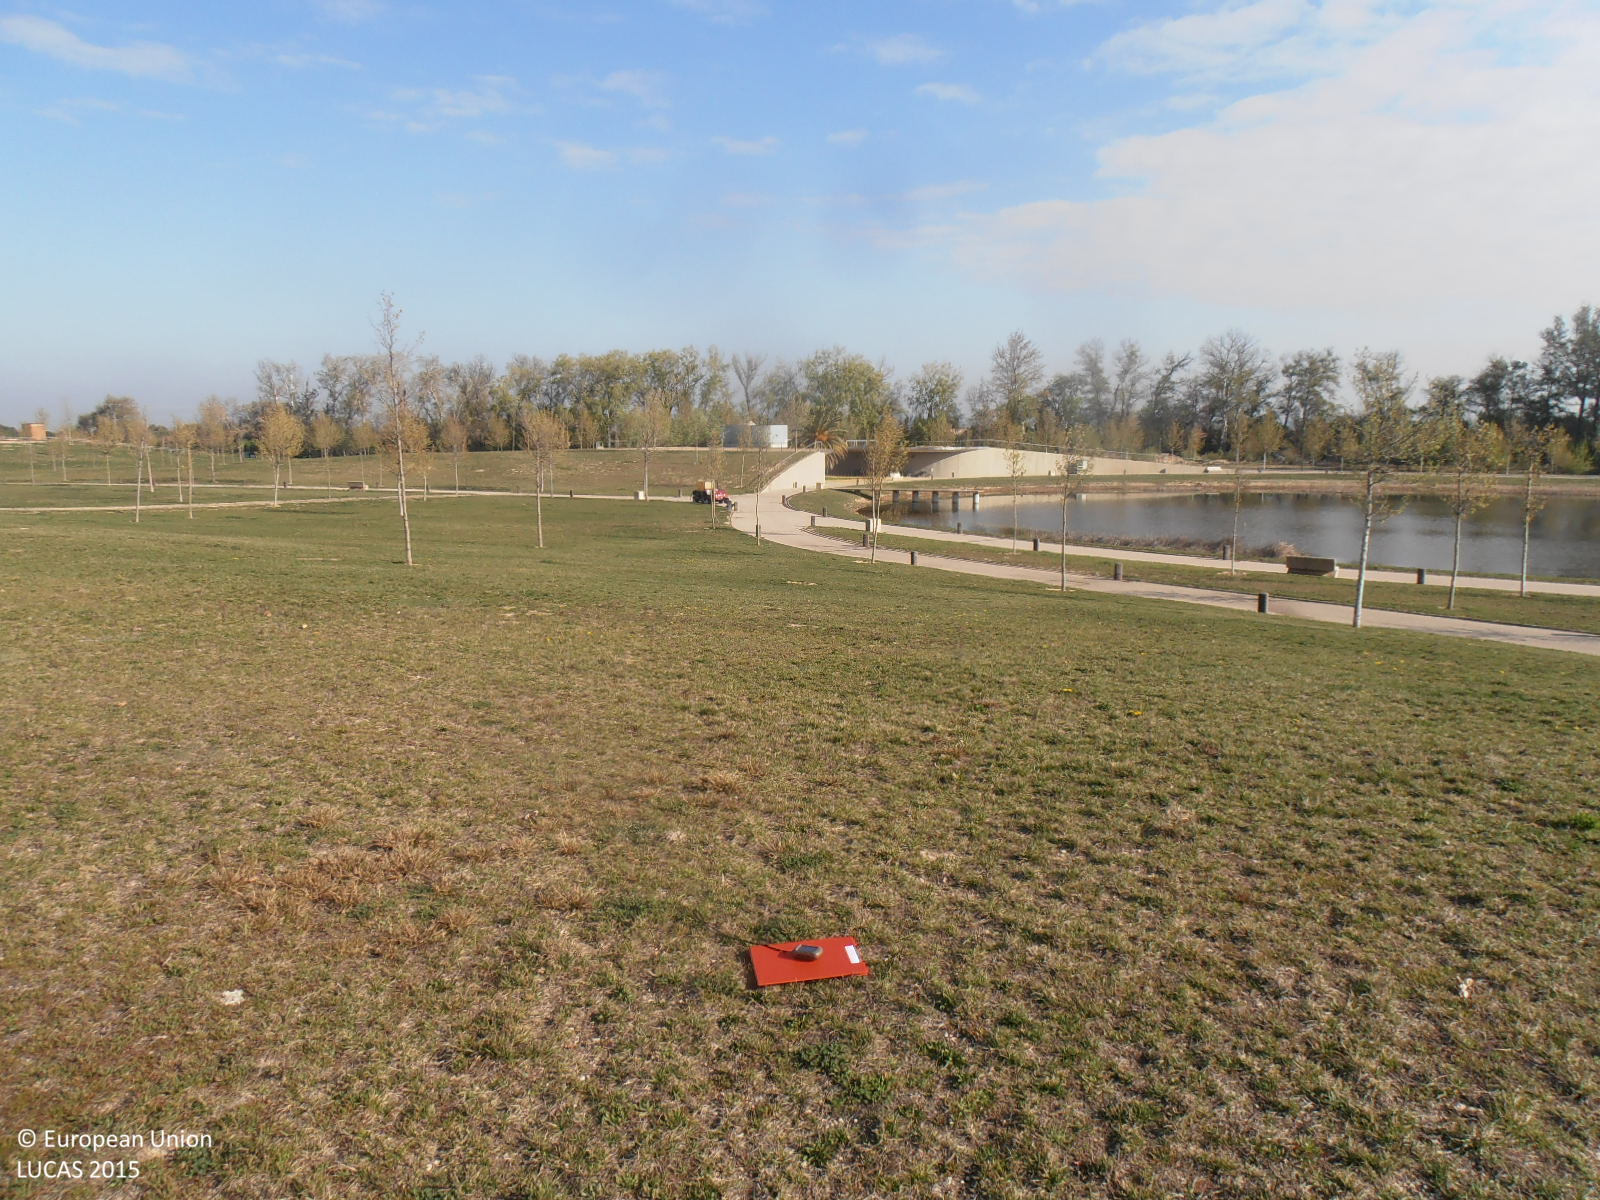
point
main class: Grassland
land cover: Grassland with sparse tree/shrub cover
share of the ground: > 75 %
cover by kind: herbaceous plants 95 %, broadleaved forest trees 5 %
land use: Sport
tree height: < 5 m
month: April
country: ES
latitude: 41.6539
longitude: -0.9859
